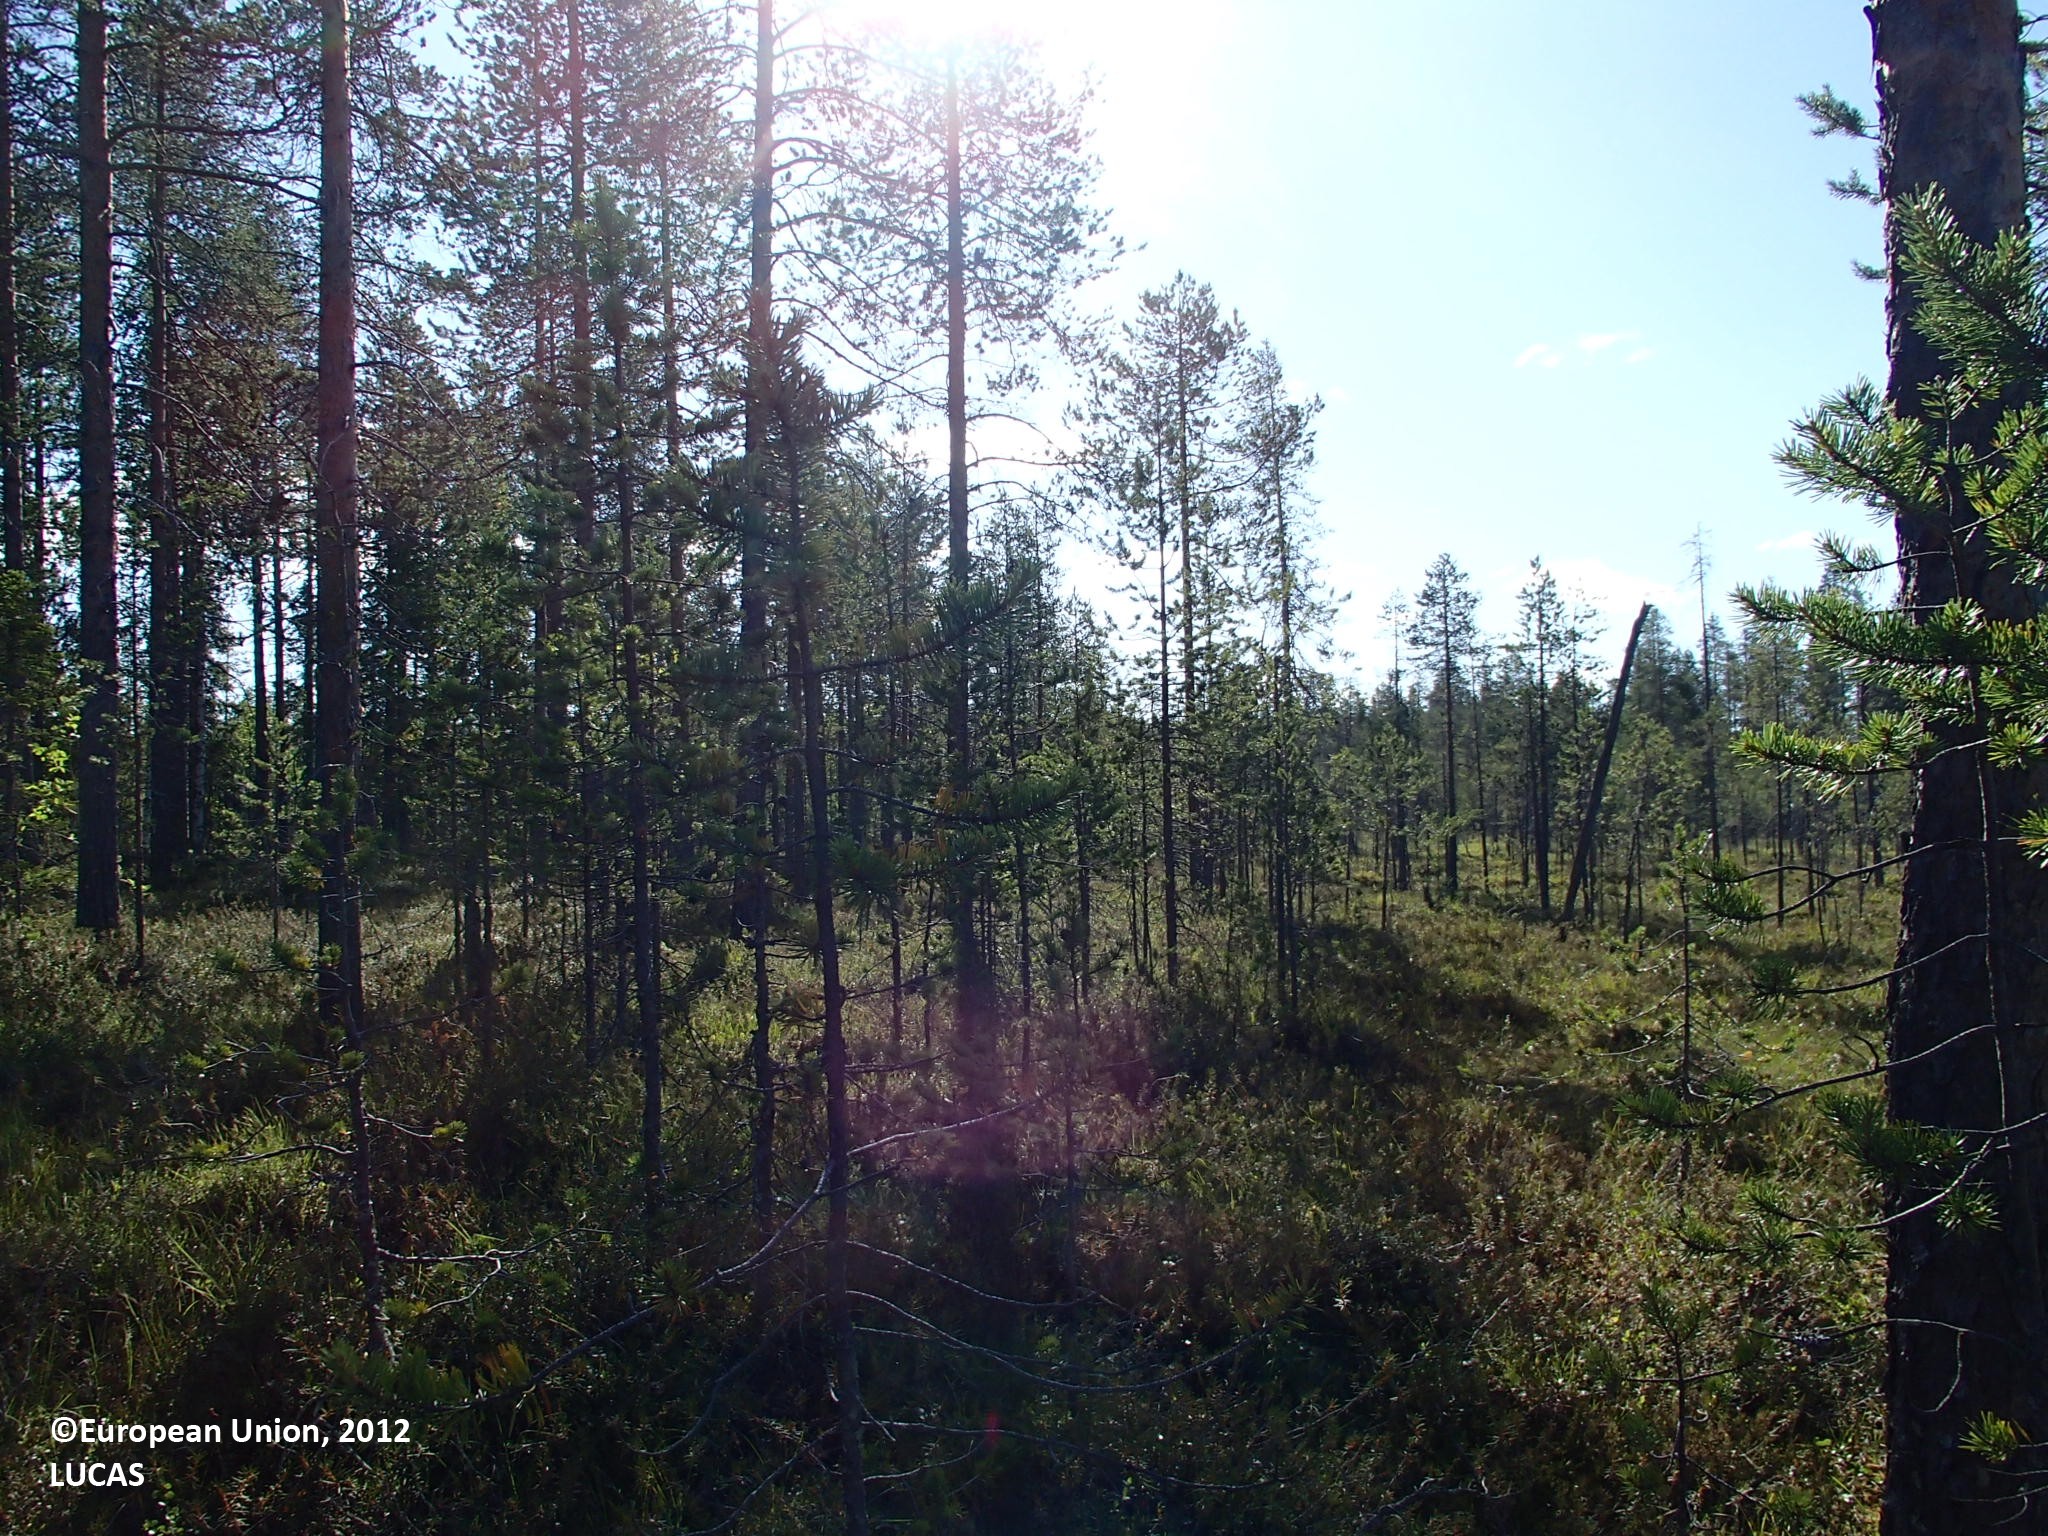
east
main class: Woodland
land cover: Pine dominated coniferous woodland
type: boreal forest
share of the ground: 10 - 25 %
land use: Forestry
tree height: > 5 m
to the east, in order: Pine dominated coniferous woodland; Other mixed woodland; Pine dominated coniferous woodland; Peatbogs; Pine dominated coniferous woodland
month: July
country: FI
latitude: 66.8268
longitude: 25.5688
